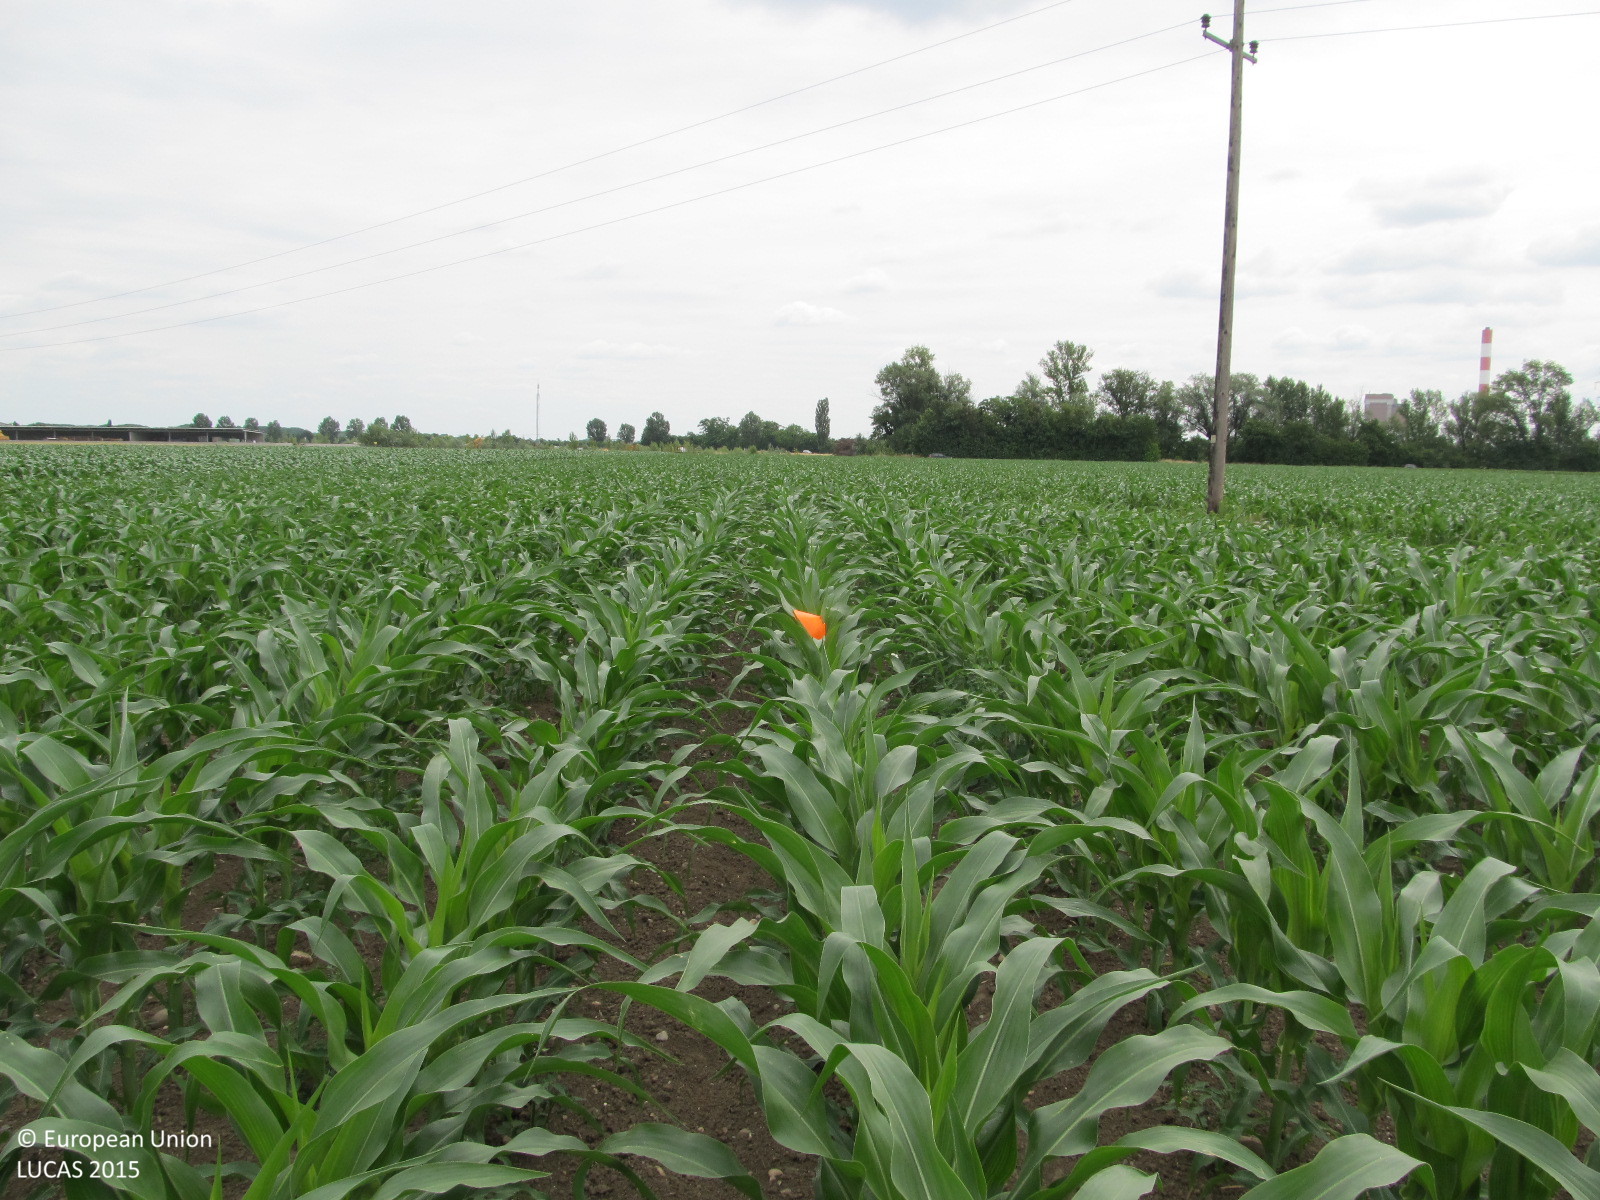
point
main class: Cropland
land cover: Maize
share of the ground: 25 - 50 %
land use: Agriculture (excluding fallow land and kitchen gardens)
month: June
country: AT
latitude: 48.3362
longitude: 15.8989
